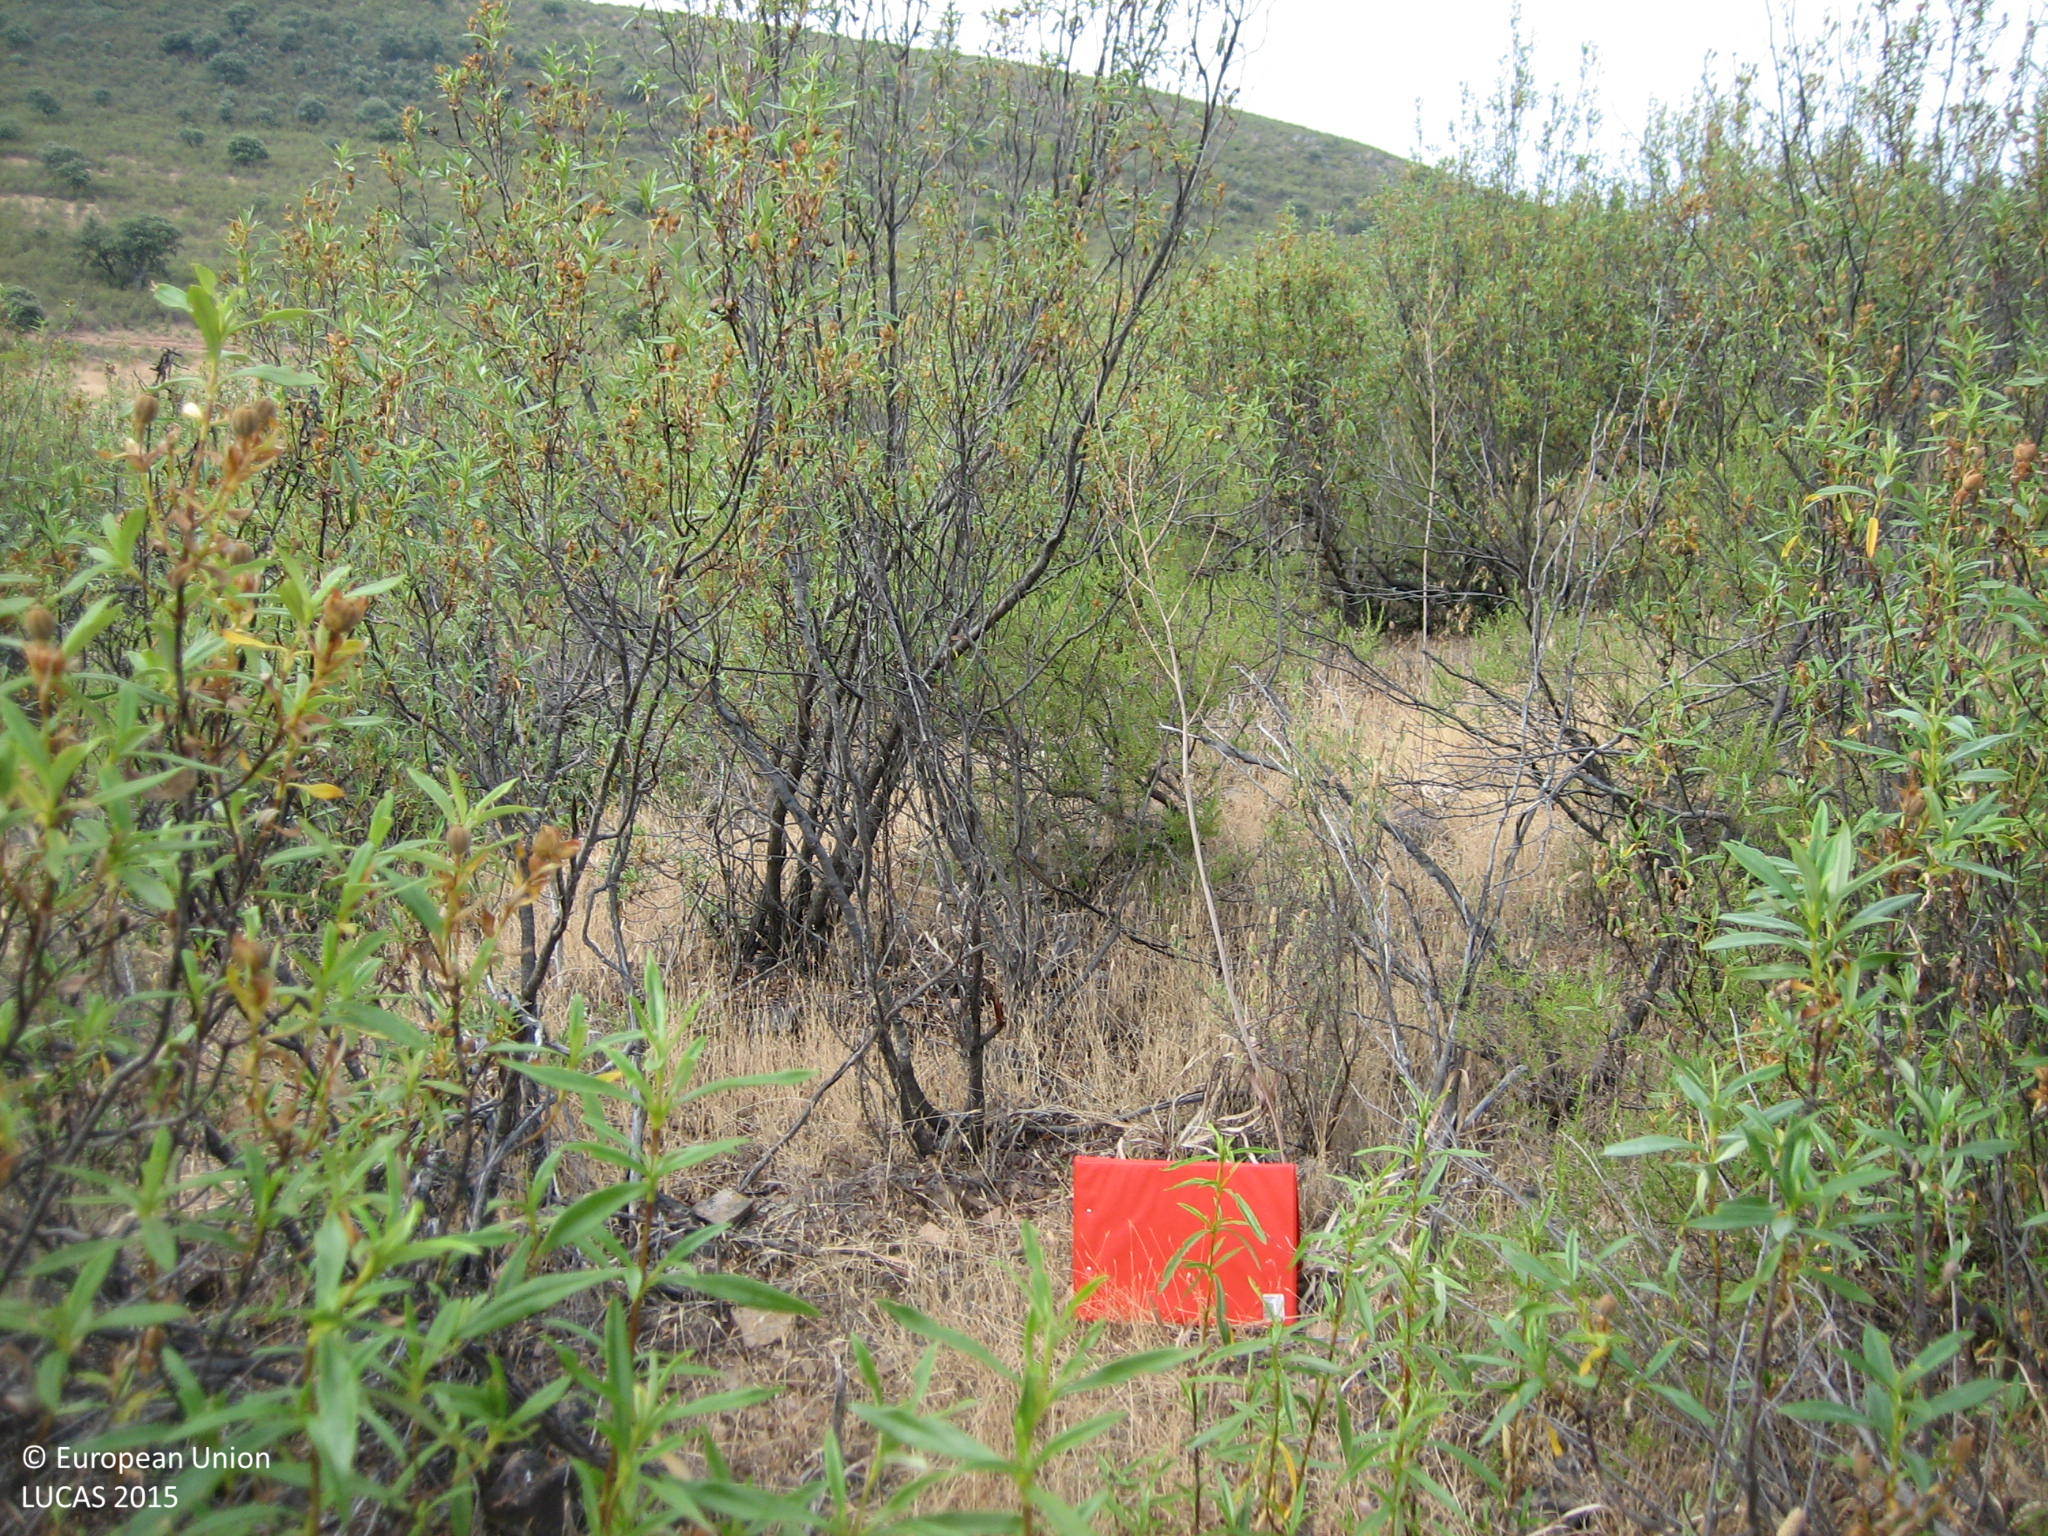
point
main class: Shrubland
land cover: Shrubland with sparse tree cover
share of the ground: > 75 %
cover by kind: shrubs 95 %, broadleaved forest trees 5 %
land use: Semi-natural and natural areas not in use
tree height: < 5 m
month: June
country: ES
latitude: 39.3211
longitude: -4.9214
